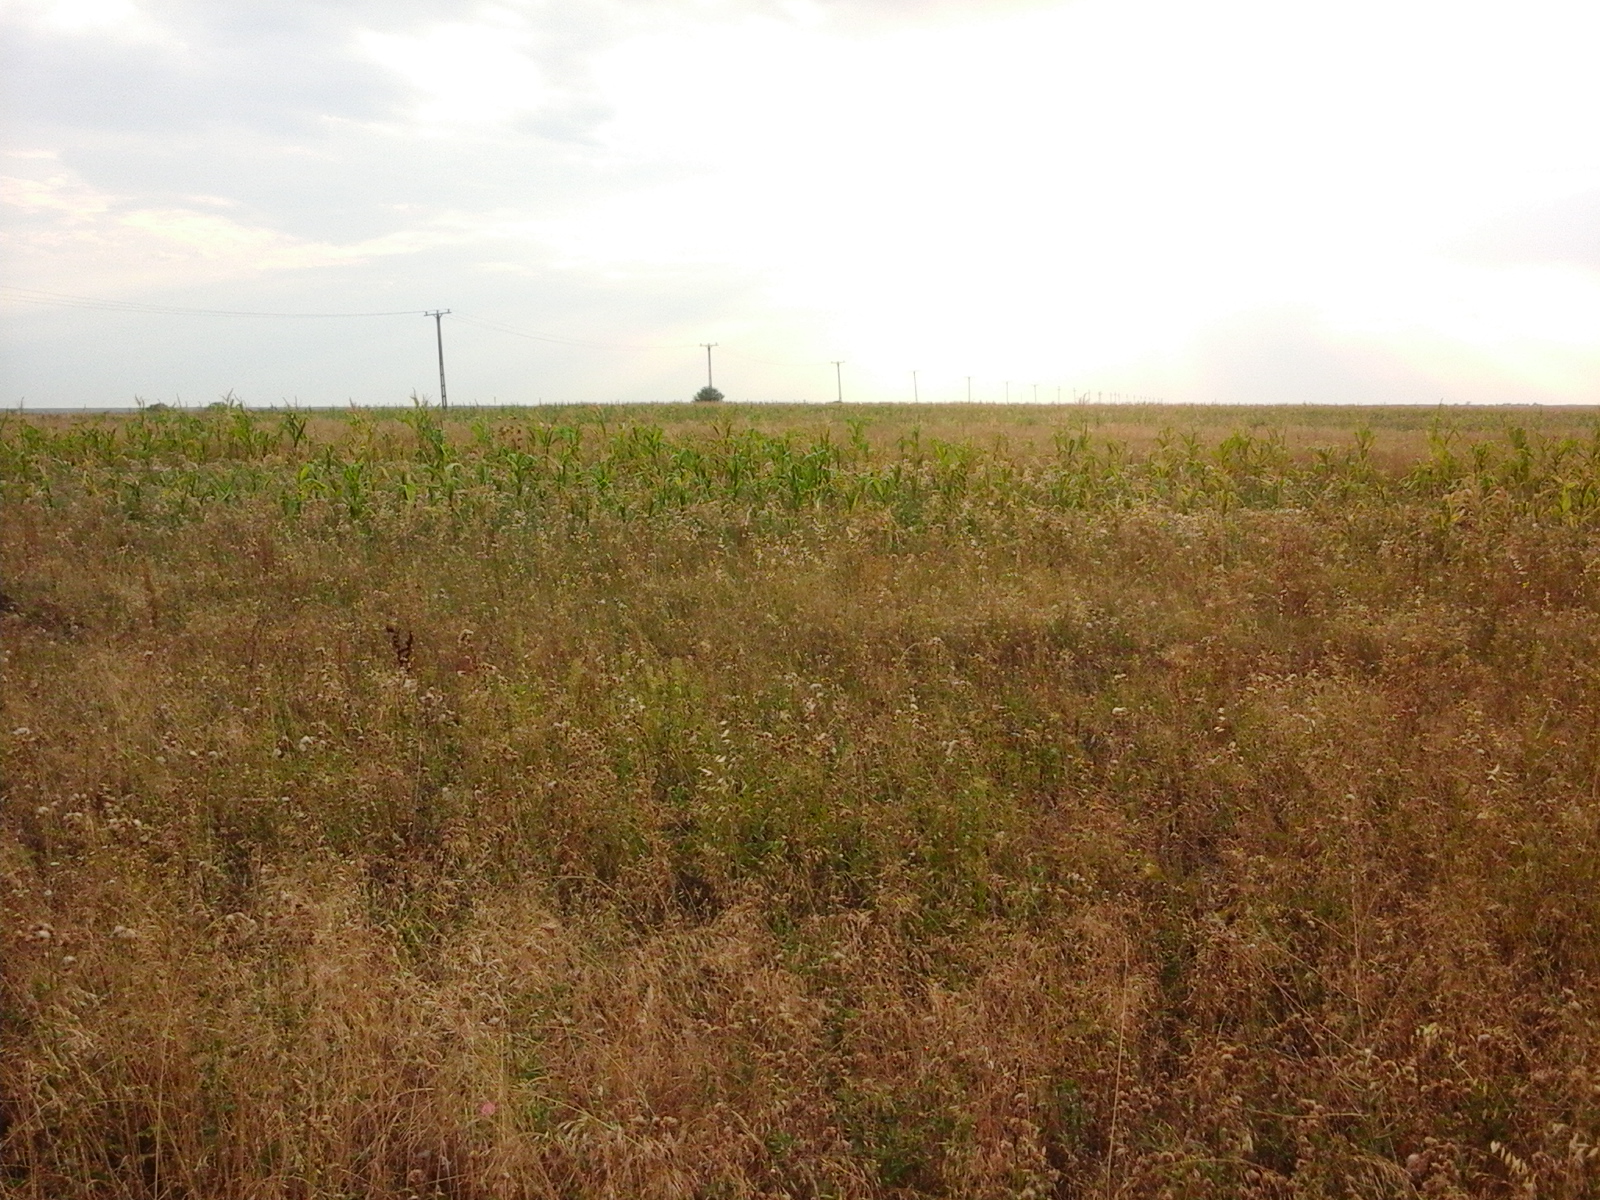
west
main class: Grassland
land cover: Grassland without tree/shrub cover
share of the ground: > 75 %
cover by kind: herbaceous plants 100 %
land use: Agriculture (excluding fallow land and kitchen gardens)
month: August
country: RO
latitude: 44.3858
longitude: 23.2919
